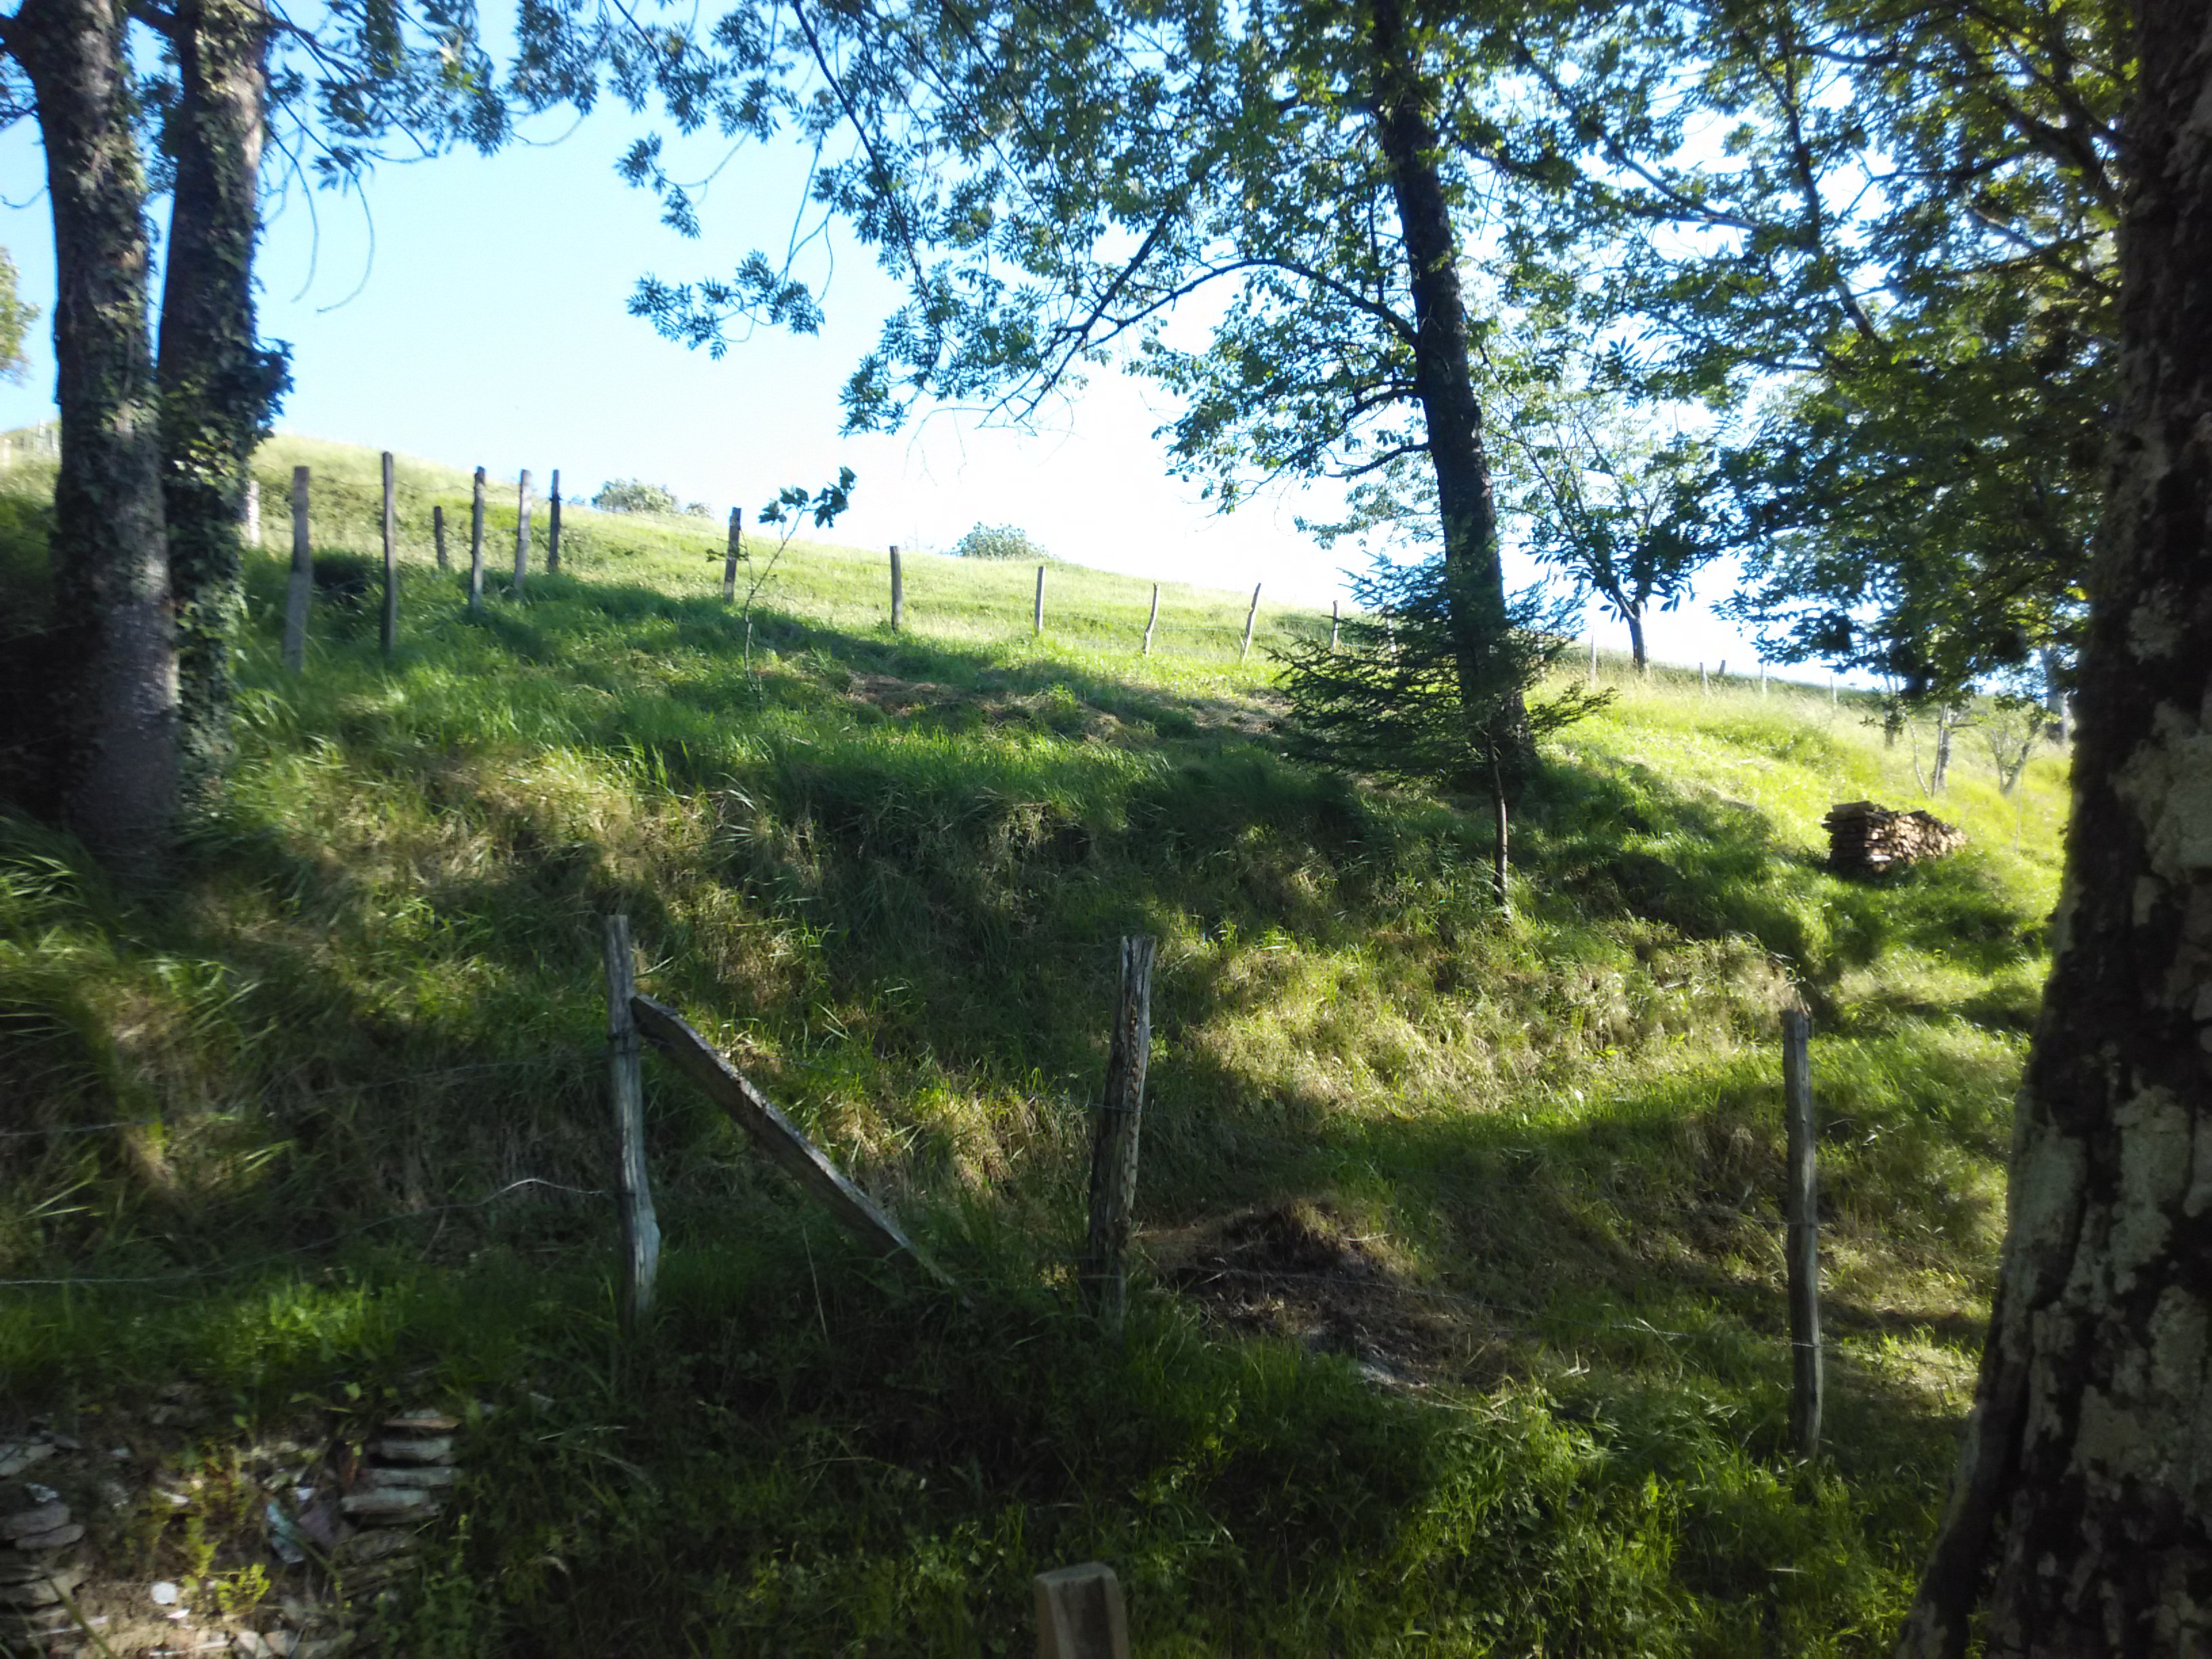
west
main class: Woodland
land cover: Broadleaved woodland
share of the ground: > 75 %
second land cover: Grassland without tree/shrub cover
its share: 10 - 25 %
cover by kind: broadleaved forest trees 70 %, herbaceous plants 20 %, coniferous forest trees 10 %
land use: Forestry
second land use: Agriculture (excluding fallow land and kitchen gardens)
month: July
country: ES
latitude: 42.9778
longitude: -2.2979
